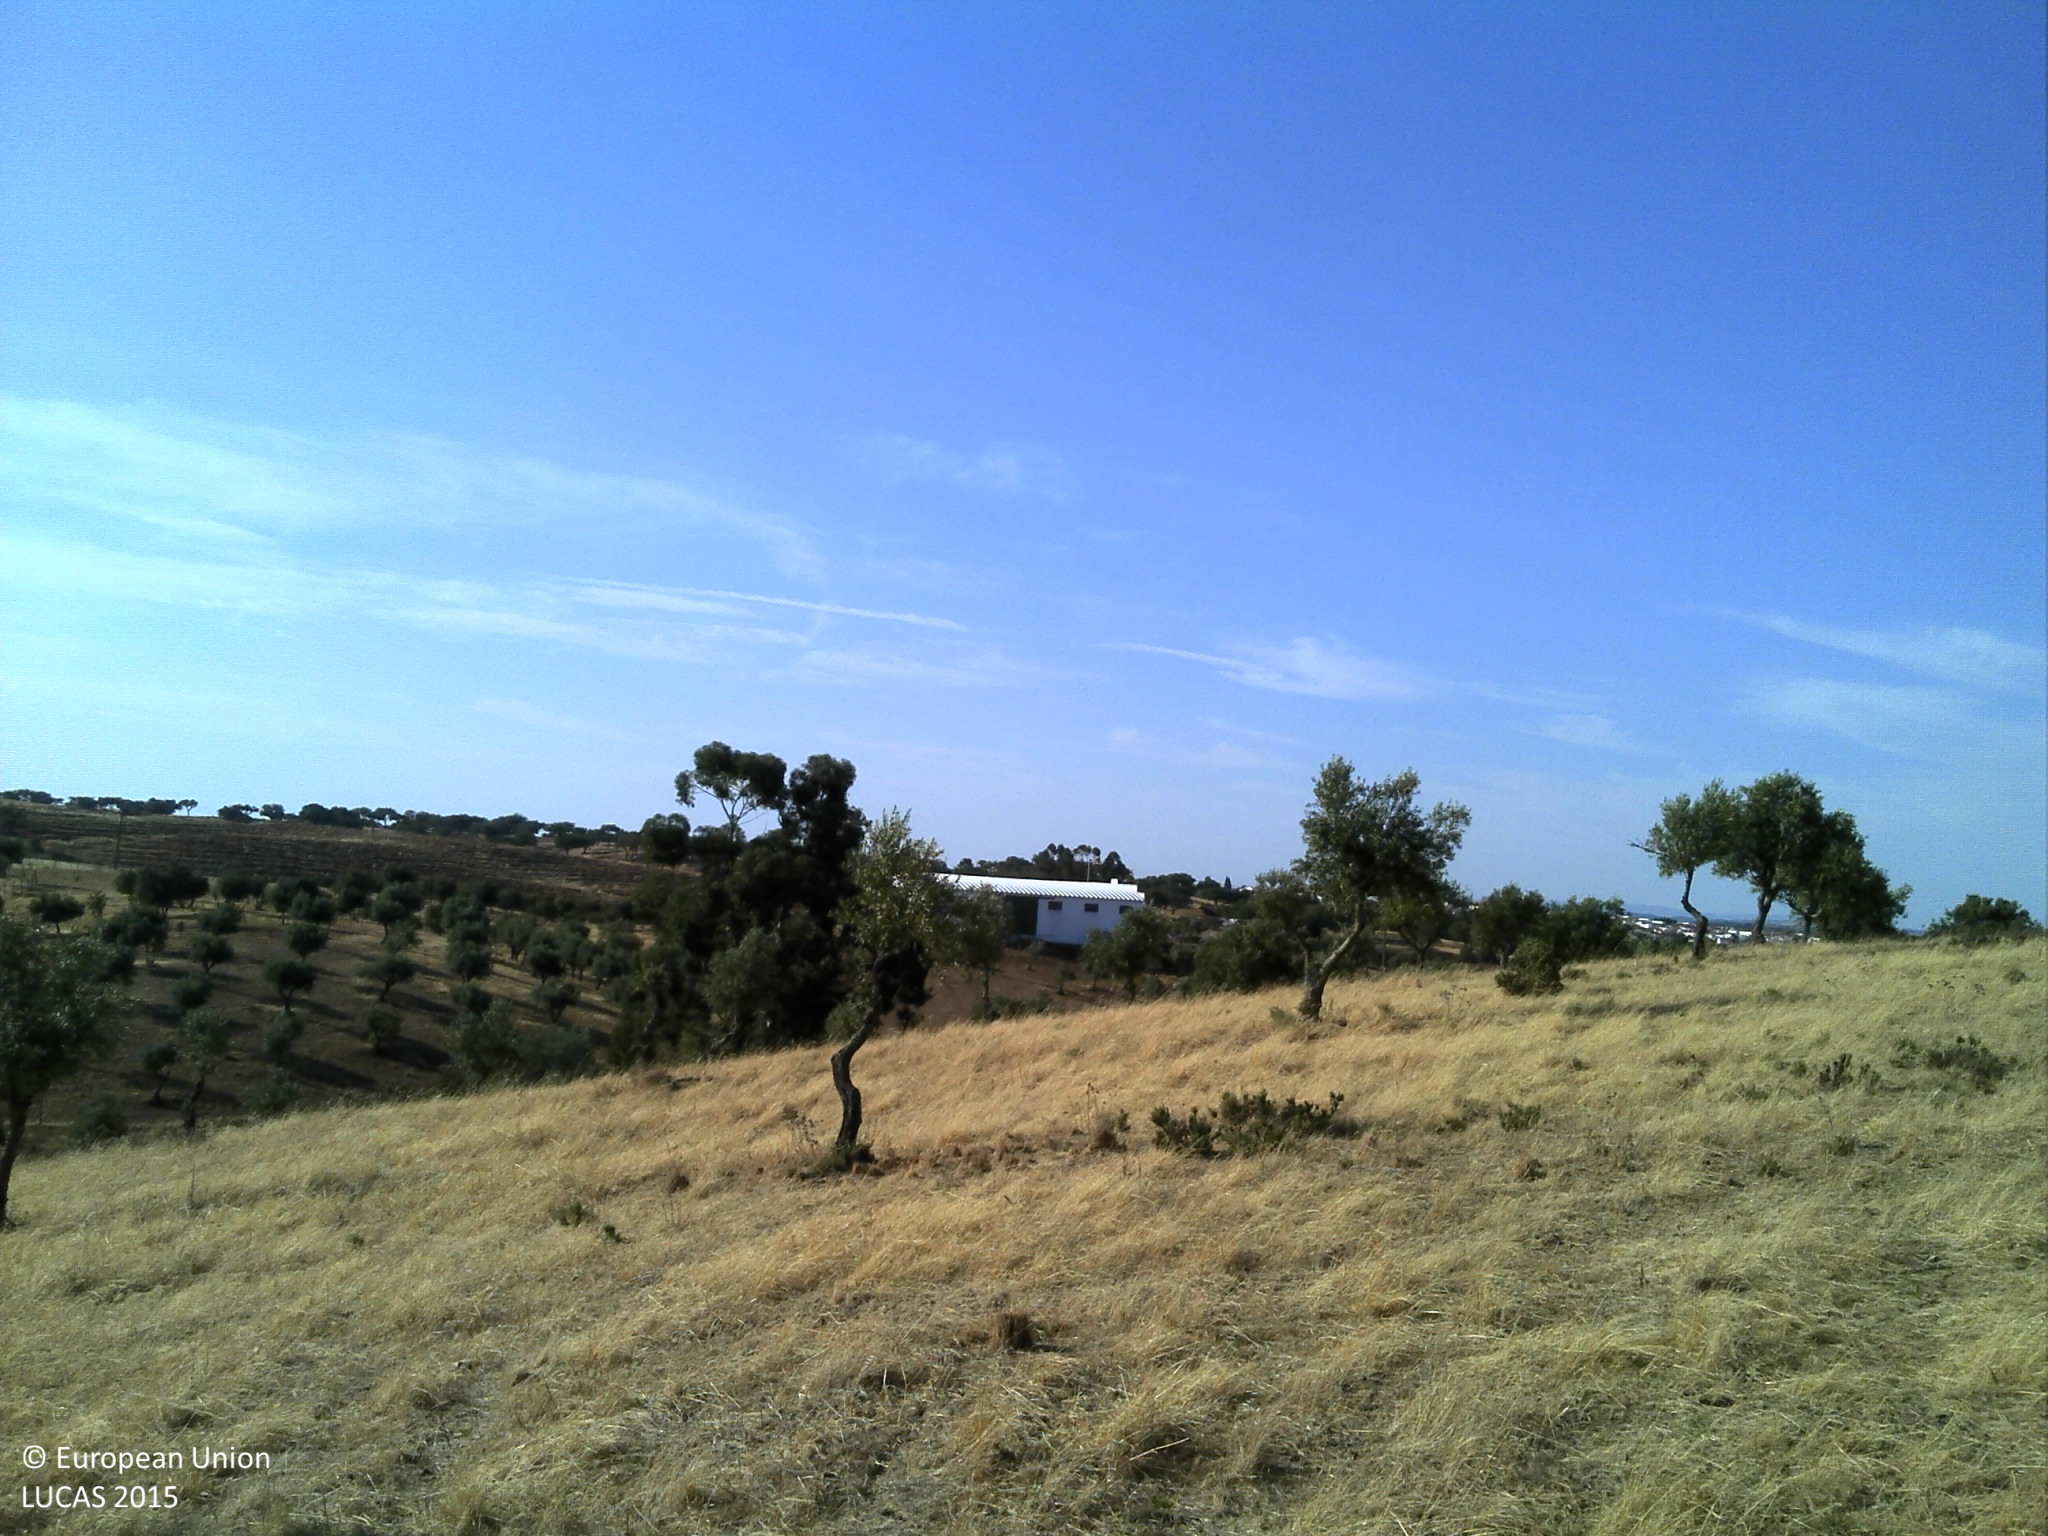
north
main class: Cropland
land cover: Olive groves
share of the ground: 10 - 25 %
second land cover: Grassland without tree/shrub cover
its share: 10 - 25 %
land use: Agriculture (excluding fallow land and kitchen gardens)
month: July
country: PT
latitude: 38.3814
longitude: -7.7179
